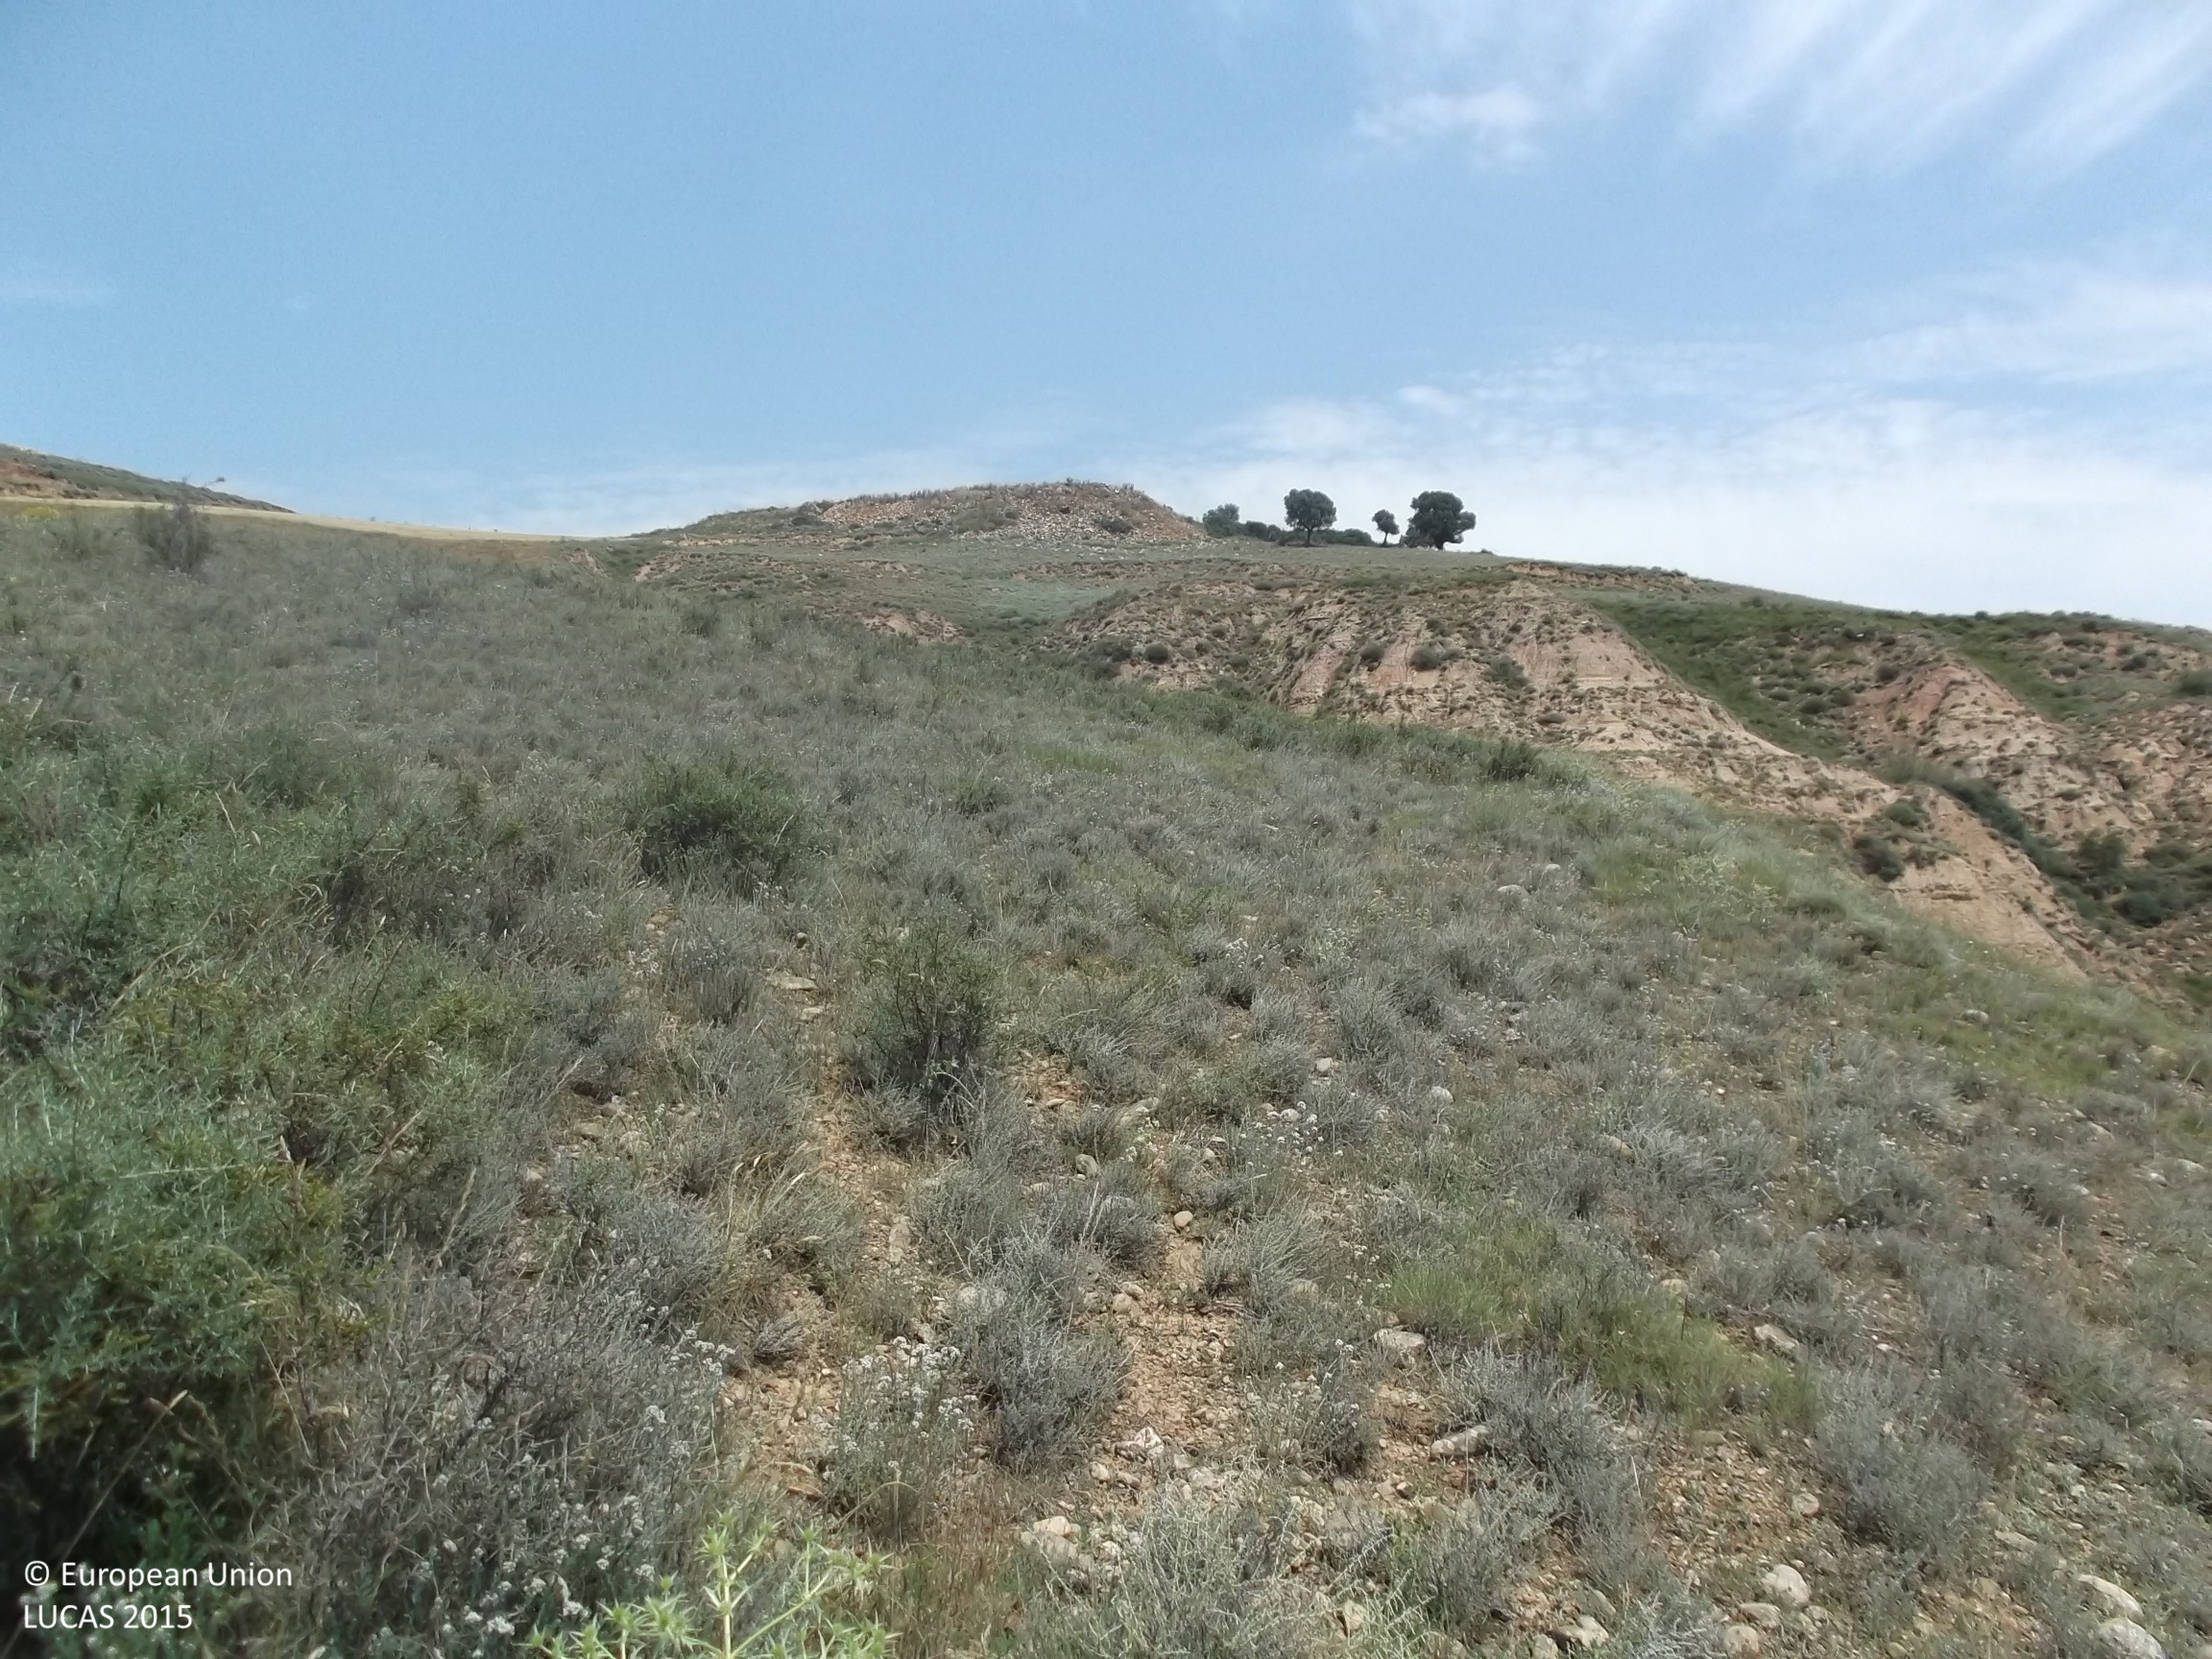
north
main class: Shrubland
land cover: Shrubland without tree cover
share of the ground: > 75 %
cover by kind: shrubs 75 %, unconsolidated bare surface 15 %, herbaceous plants 5 %
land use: Semi-natural and natural areas not in use
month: June
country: ES
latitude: 42.3642
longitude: -2.2444
